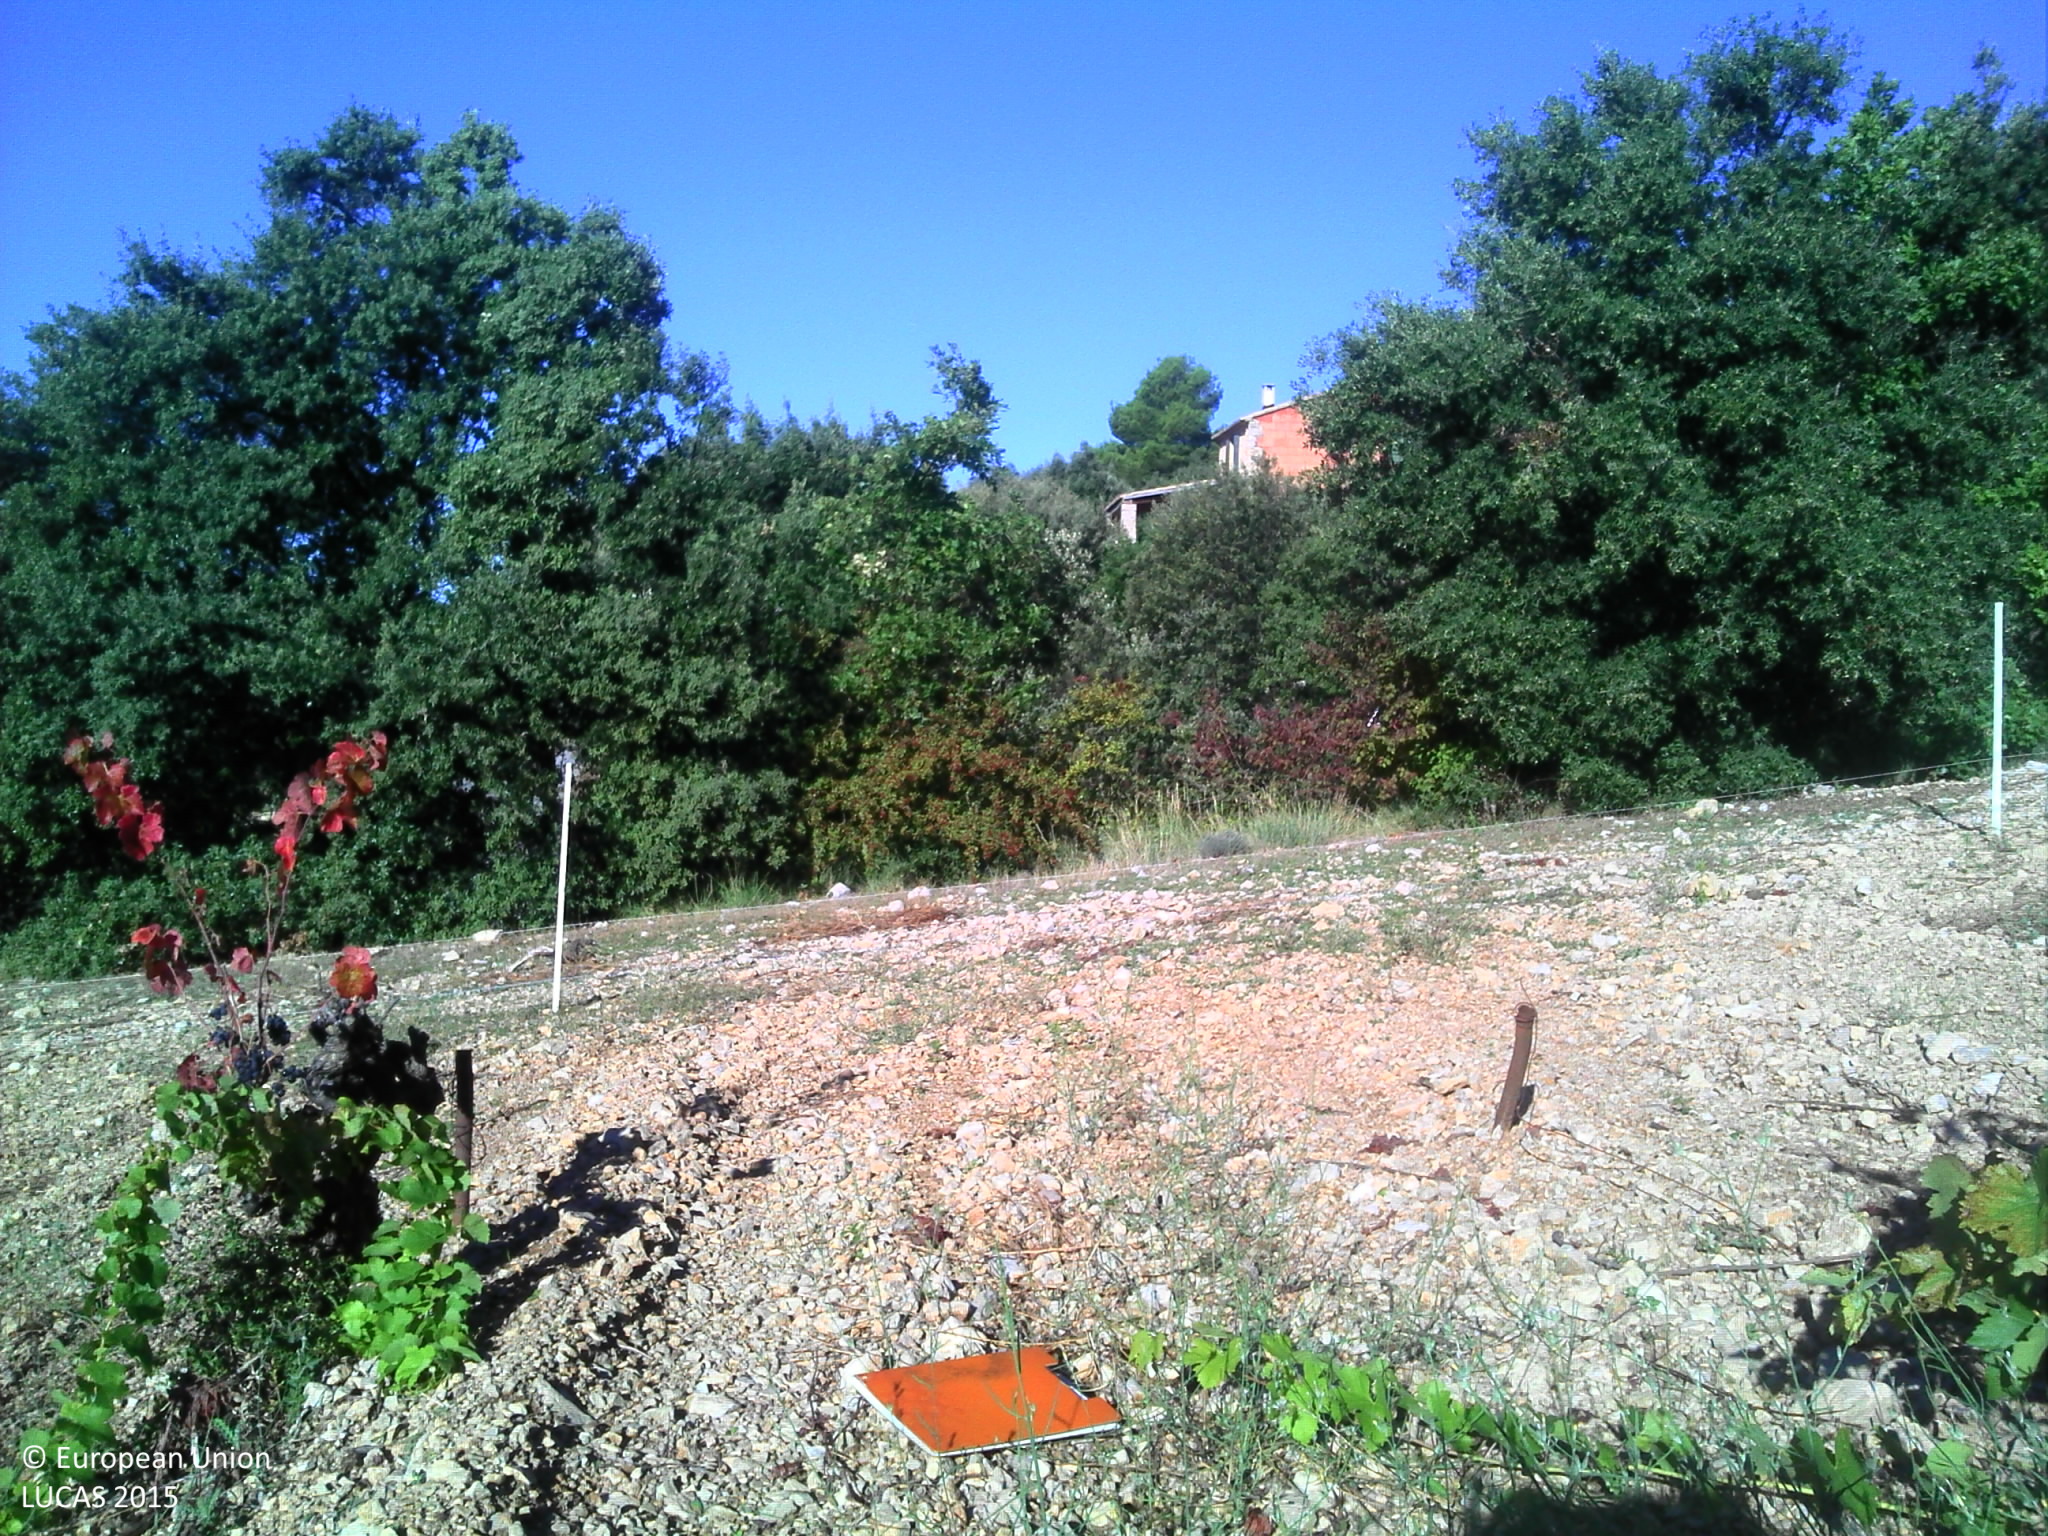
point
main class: Cropland
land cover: Vineyards
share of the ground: 25 - 50 %
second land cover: Other bare soil
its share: > 75 %
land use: Agriculture (excluding fallow land and kitchen gardens)
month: September
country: FR
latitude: 44.2952
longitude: 5.2324
